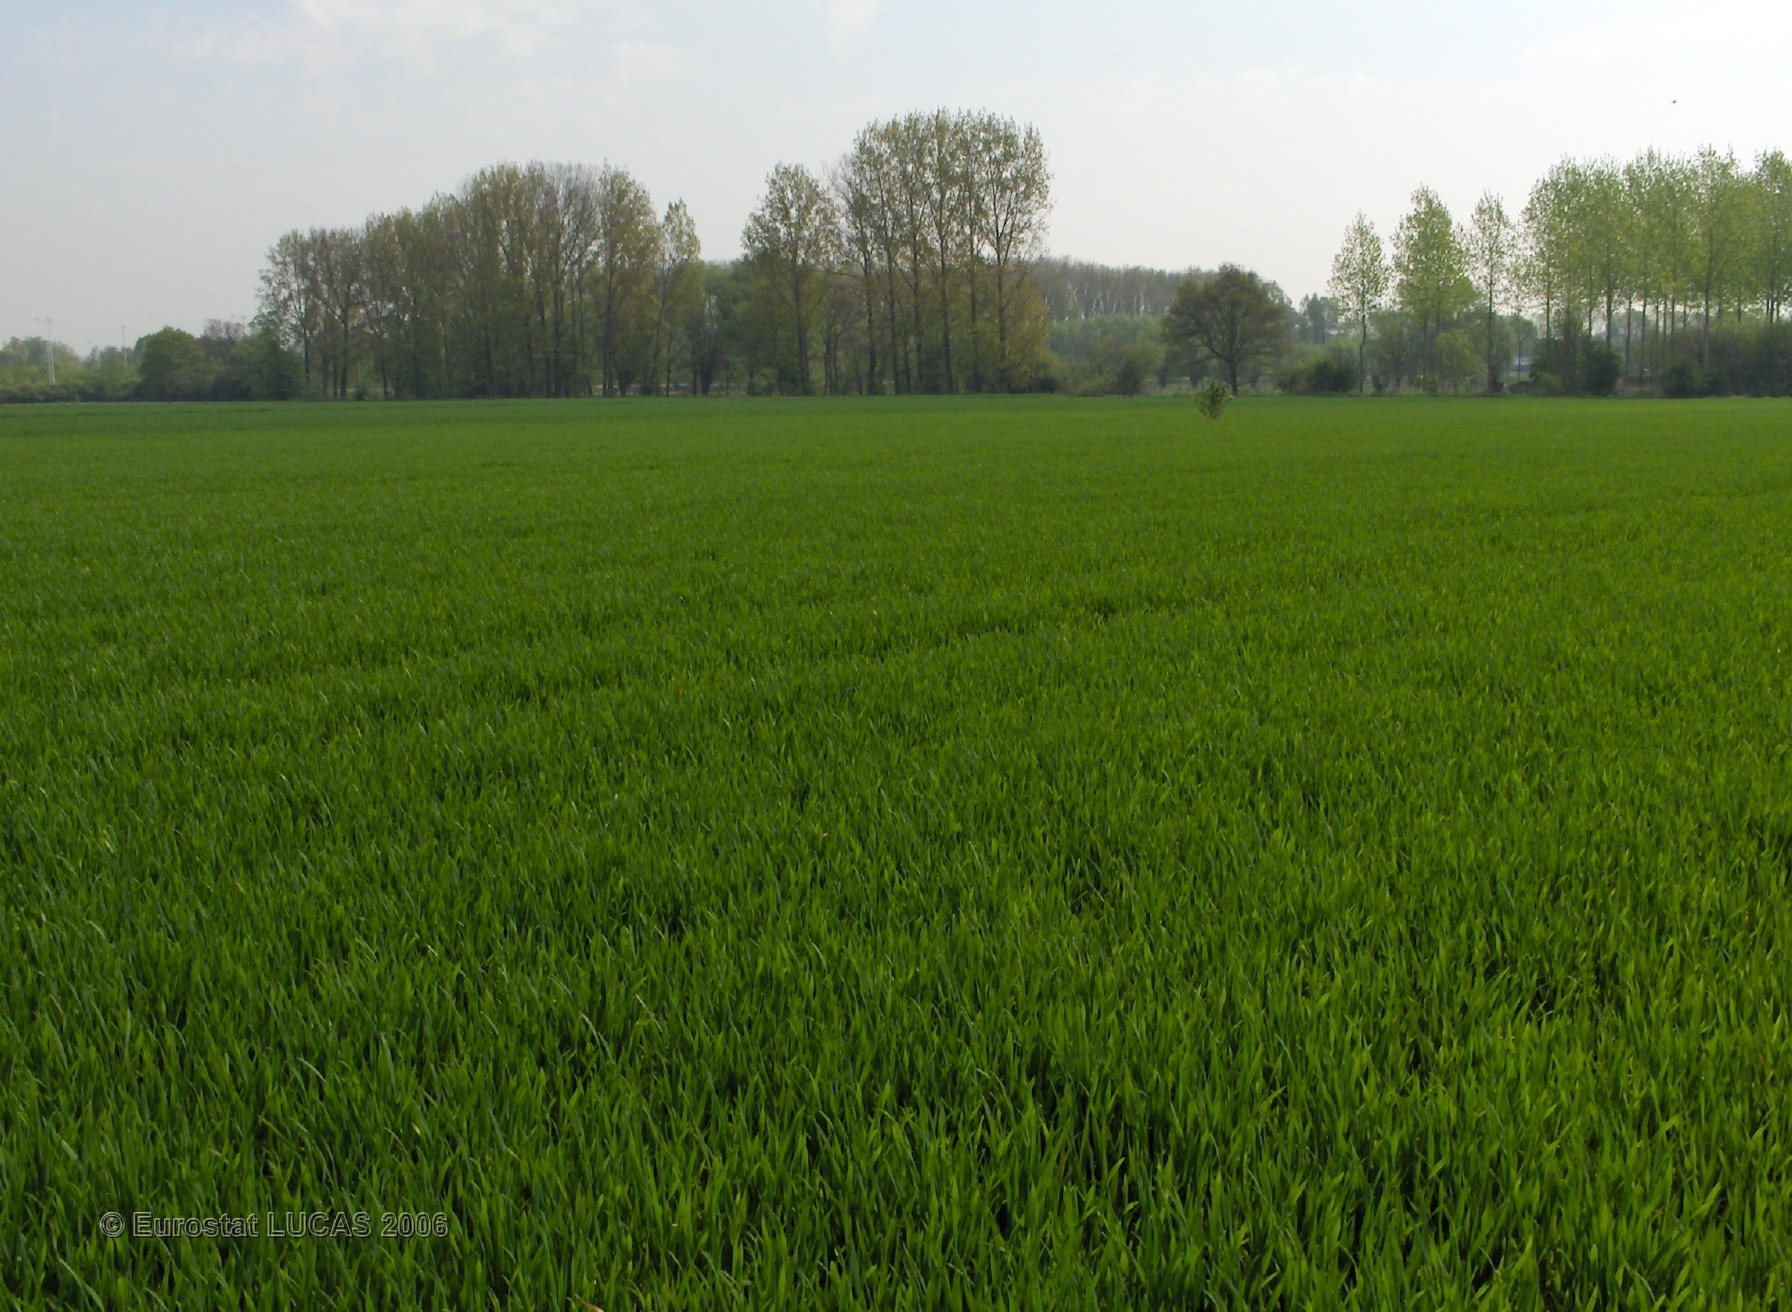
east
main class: Cropland
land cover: Common wheat
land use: Agriculture (excluding fallow land and kitchen gardens)
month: May
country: BE
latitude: 50.9699
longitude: 4.4846
